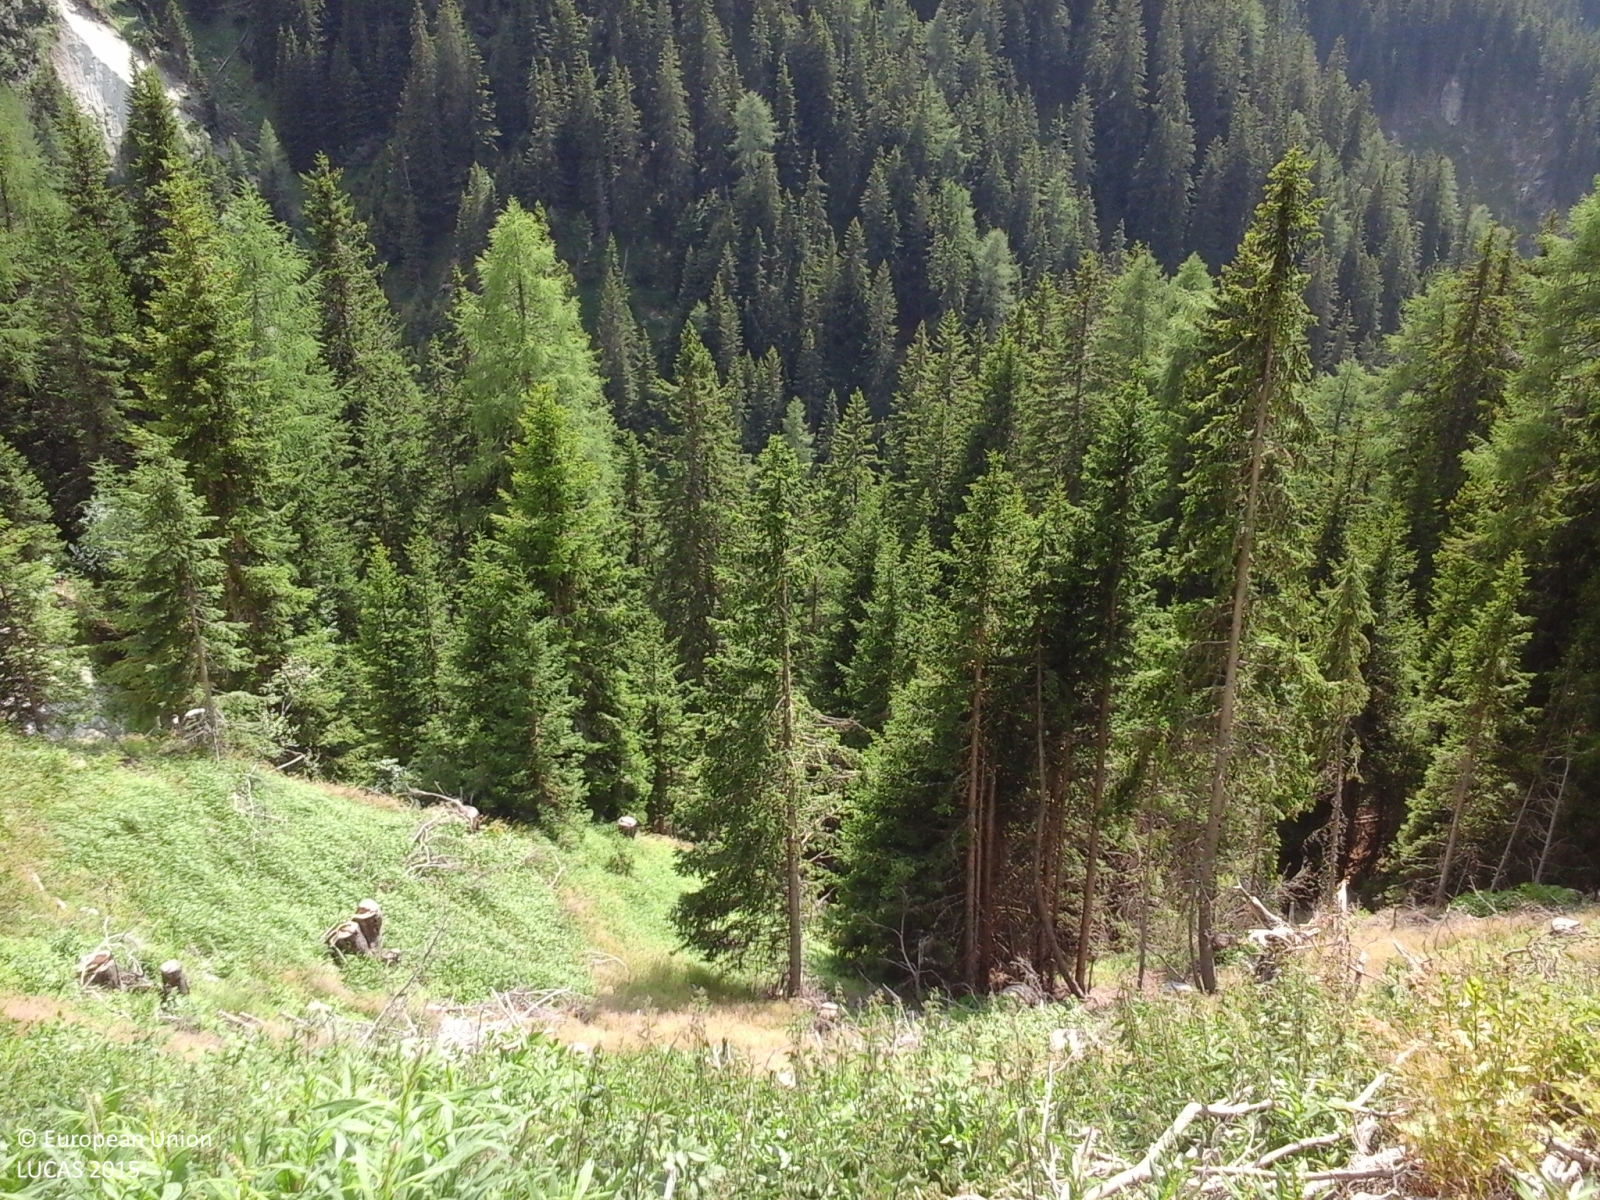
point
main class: Woodland
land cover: Spruce dominated coniferous woodland
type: alpine coniferous forest
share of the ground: > 75 %
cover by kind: coniferous forest trees 100 %
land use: Semi-natural and natural areas not in use
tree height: > 5 m
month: July
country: IT
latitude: 46.8438
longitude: 11.5850
